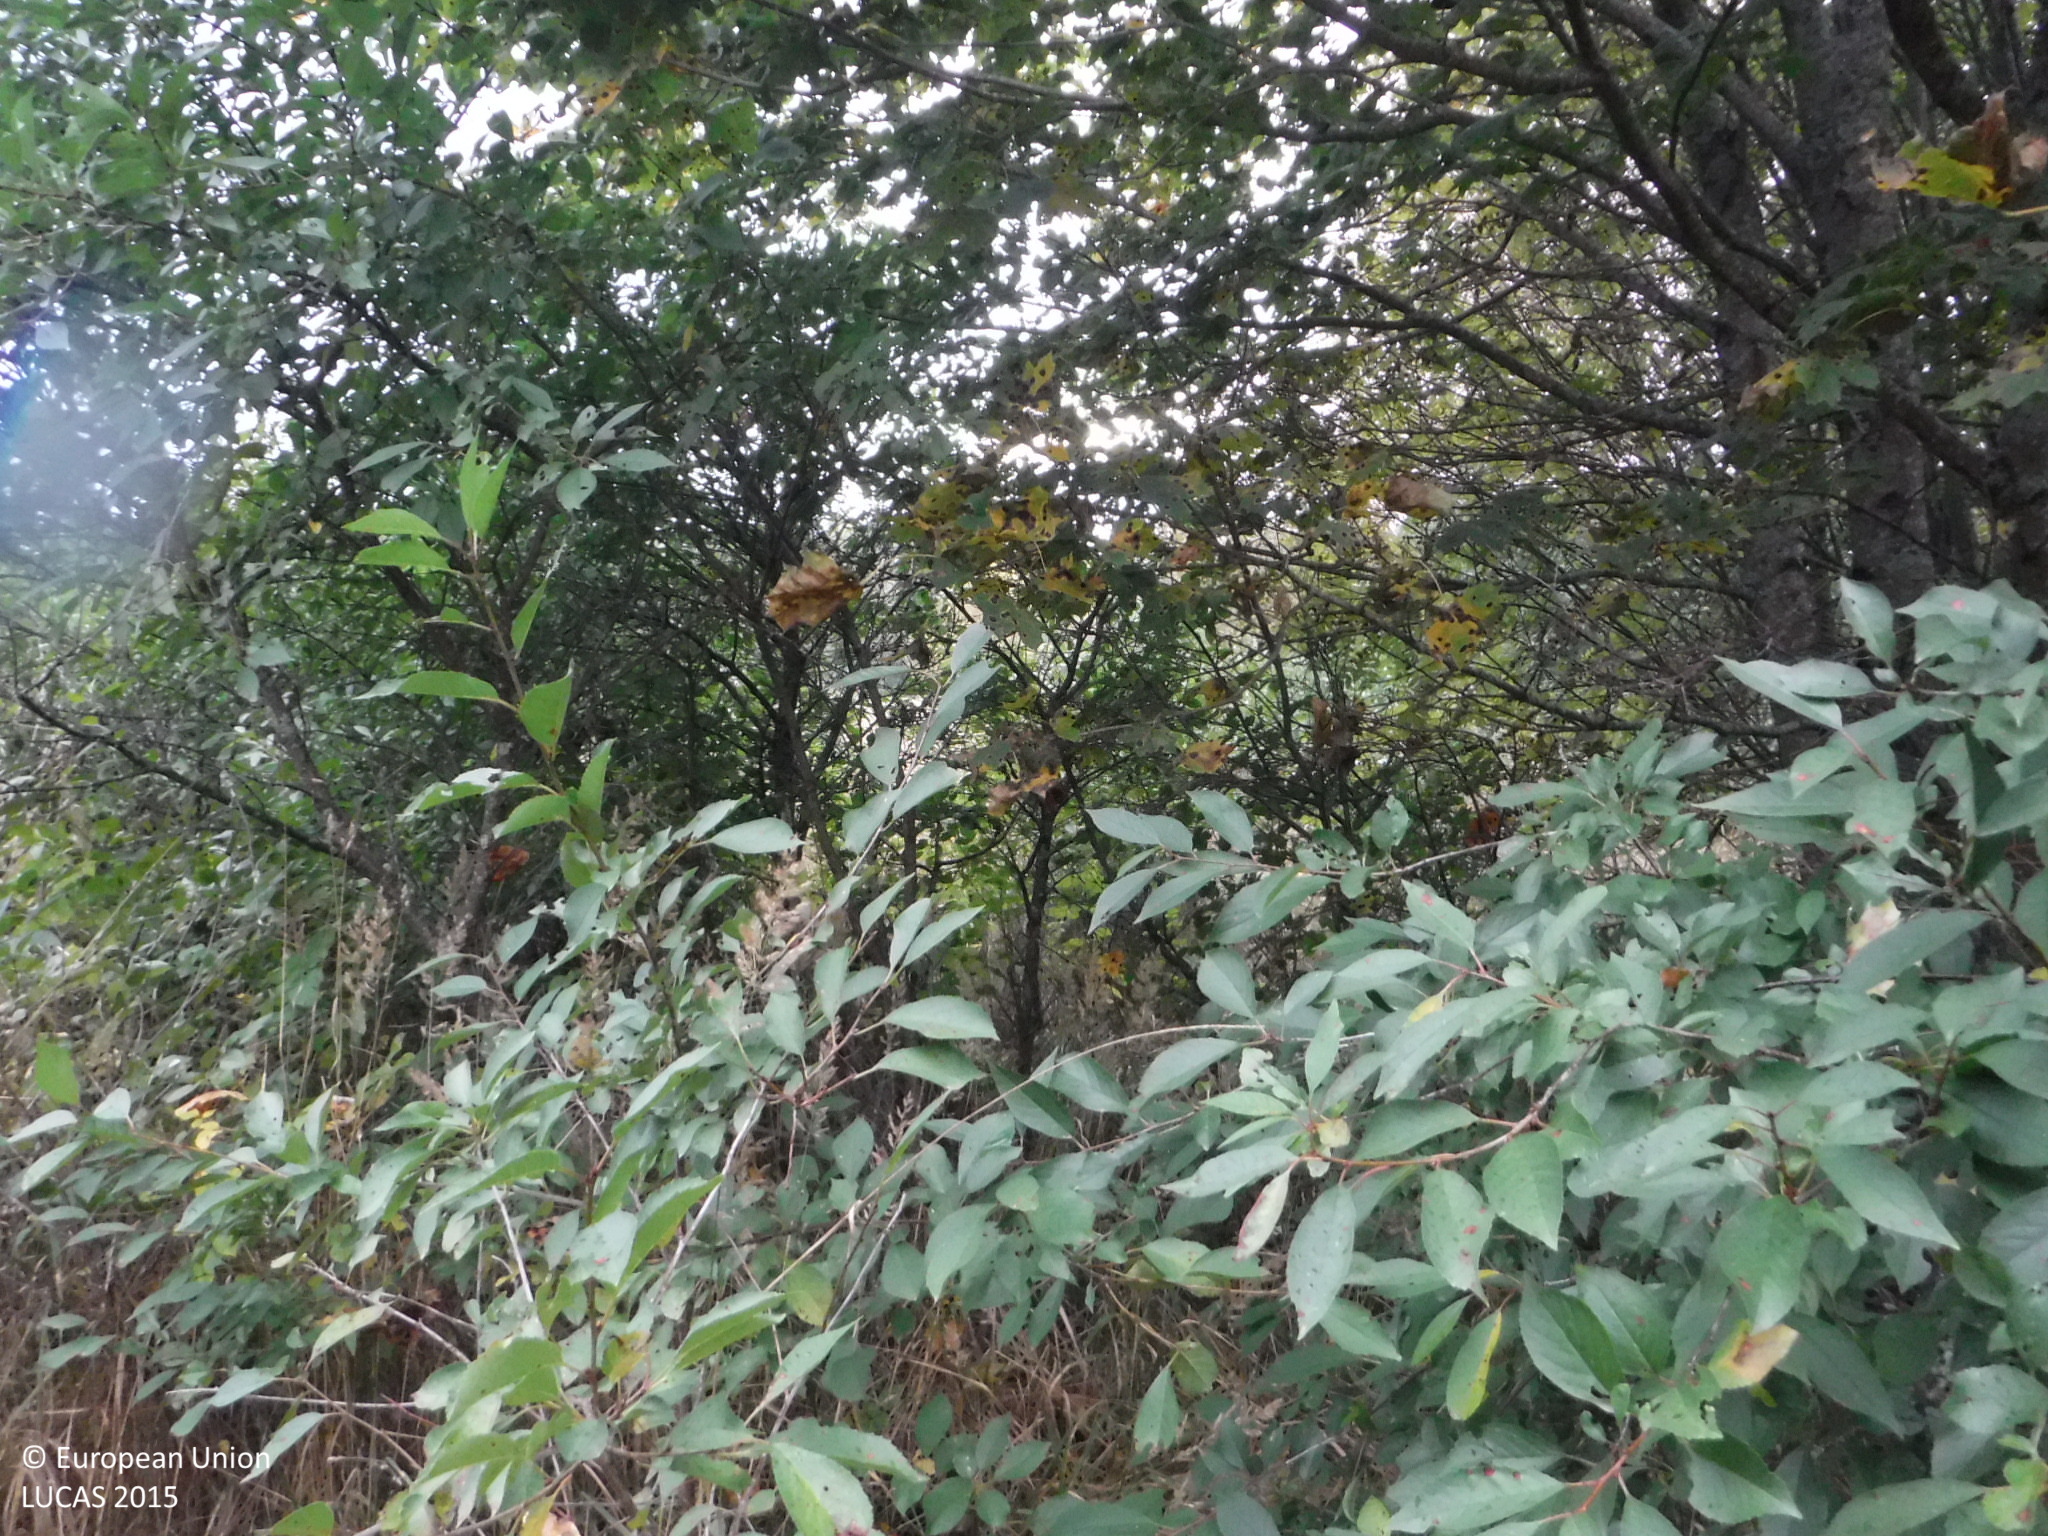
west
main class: Woodland
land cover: Broadleaved woodland
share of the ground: > 75 %
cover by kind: broadleaved forest trees 80 %, herbaceous plants 20 %
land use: Semi-natural and natural areas not in use
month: September
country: FI
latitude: 61.4871
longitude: 24.0805
